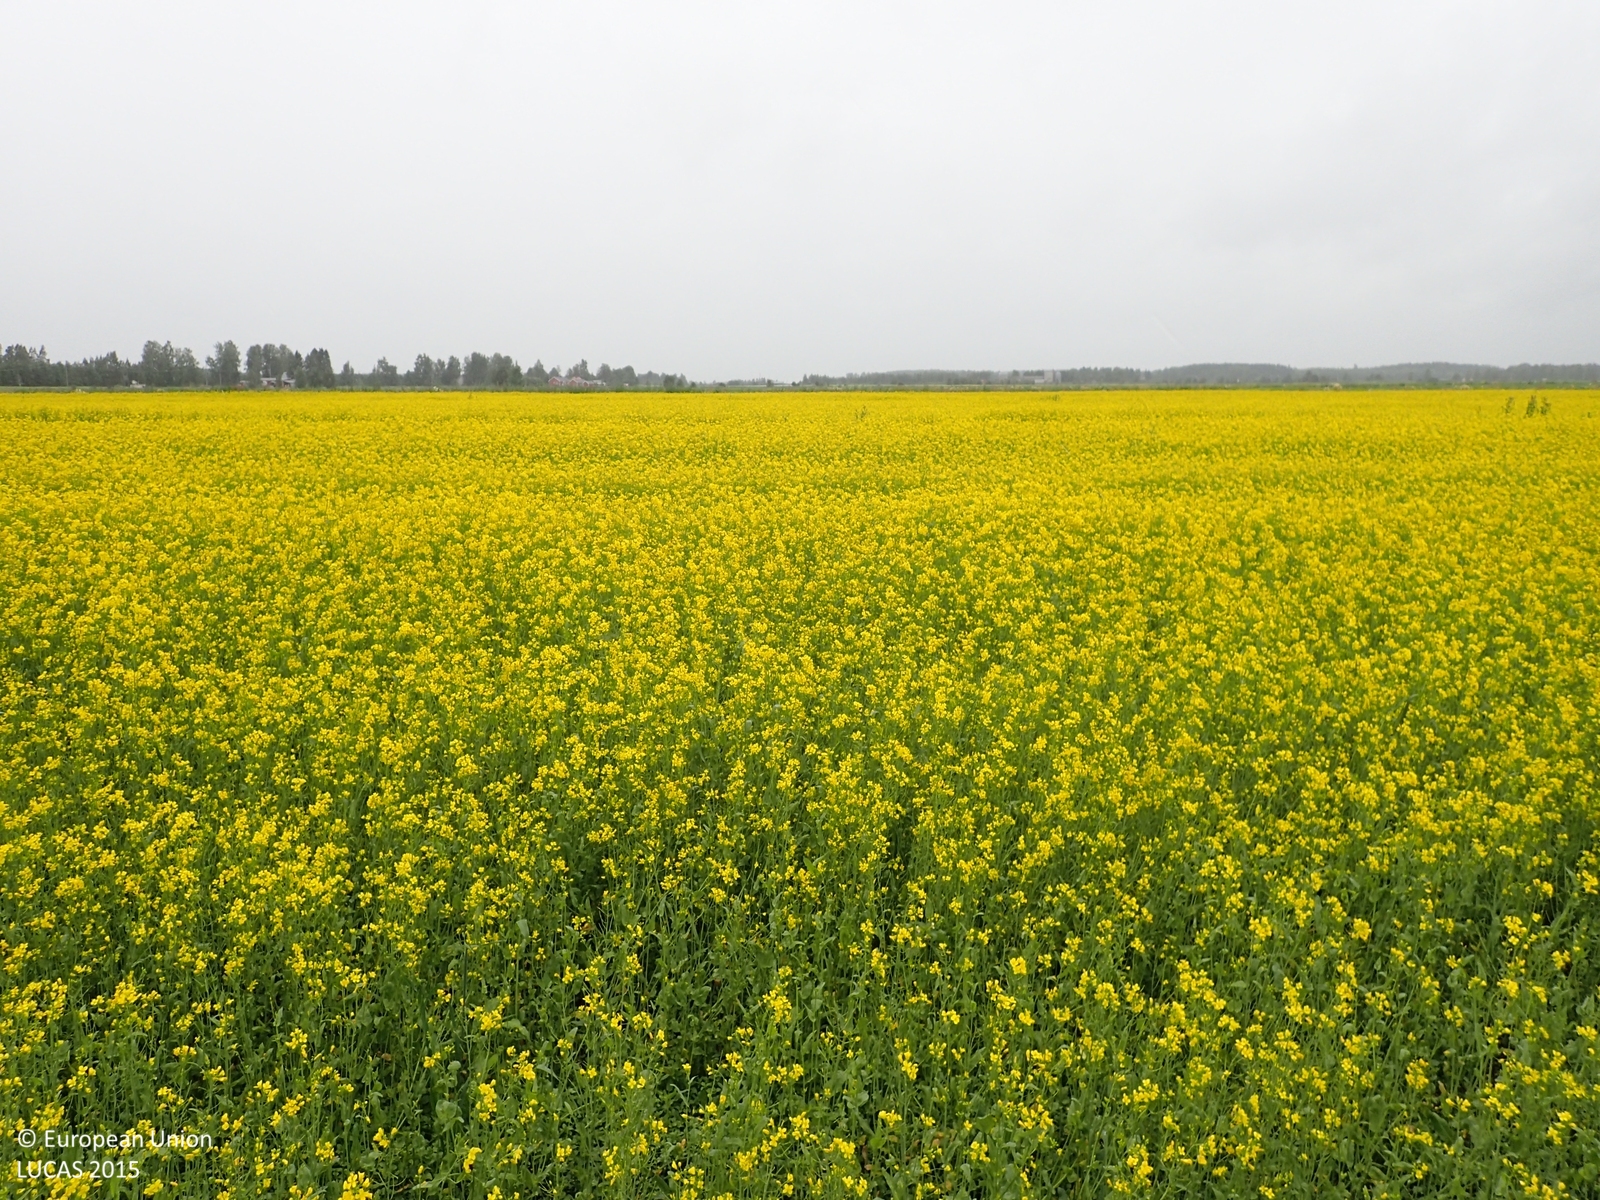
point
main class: Cropland
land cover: Rape and turnip rape
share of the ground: > 75 %
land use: Agriculture (excluding fallow land and kitchen gardens)
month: July
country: FI
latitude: 62.8537
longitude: 22.7671
